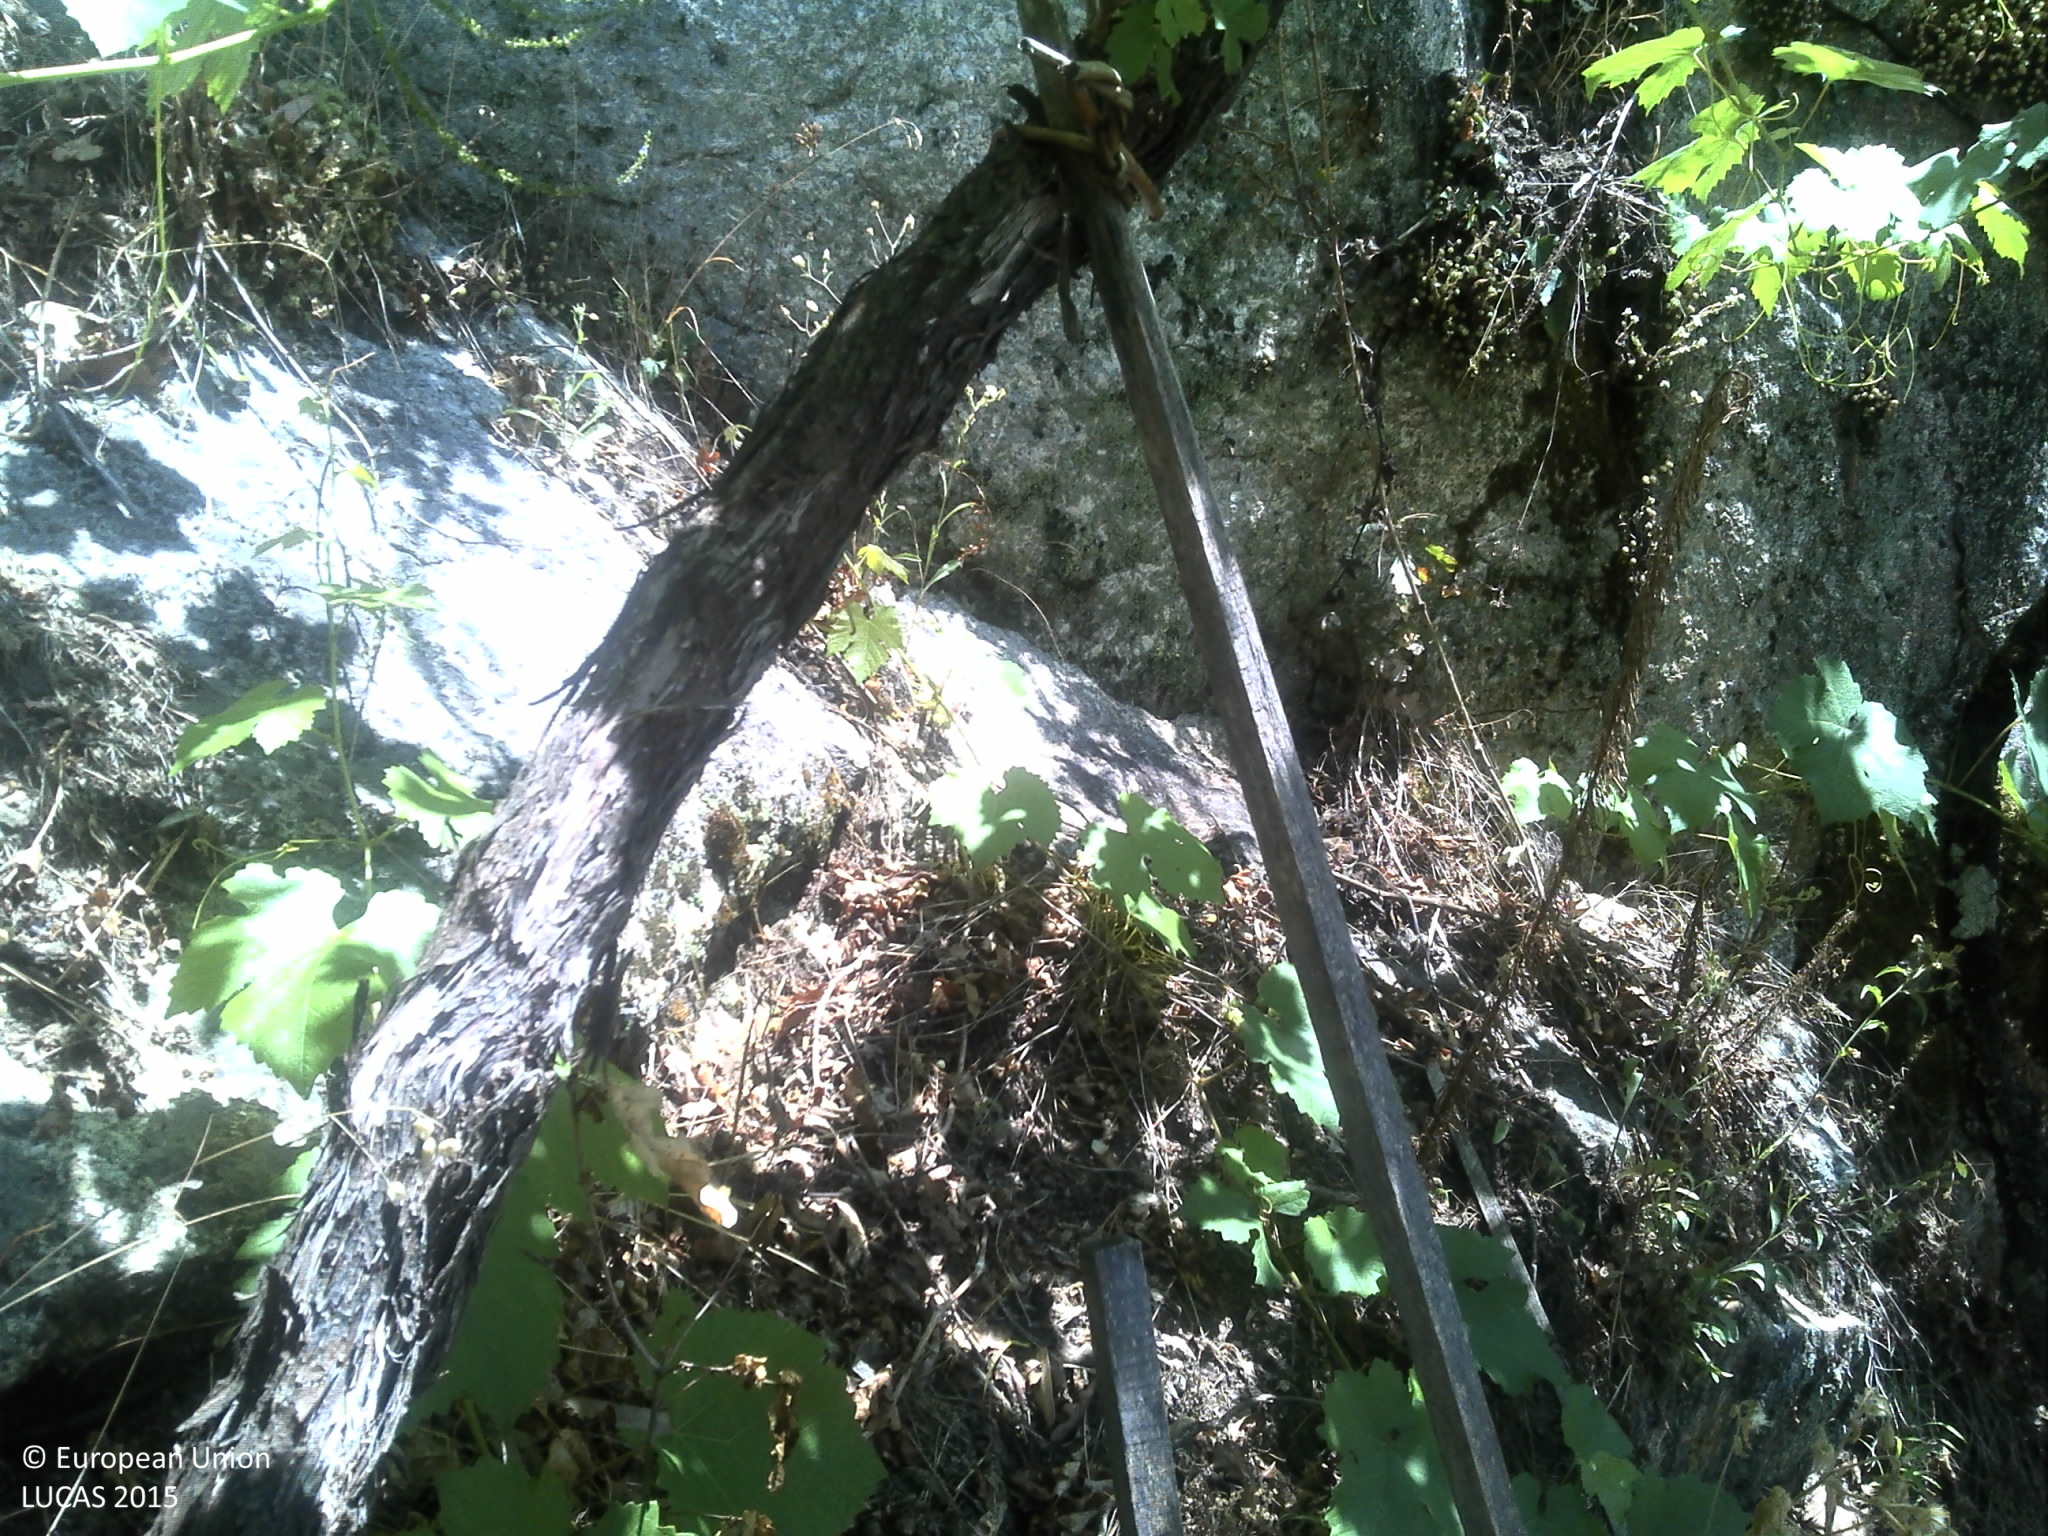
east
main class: Cropland
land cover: Vineyards
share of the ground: 50 - 75 %
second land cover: Other bare soil
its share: > 75 %
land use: Agriculture (excluding fallow land and kitchen gardens)
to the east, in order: Vineyards; Other bare soil; Grassland without tree/shrub cover; Rock outcrops; Broadleaved woodland; Pine dominated coniferous woodland; Maize; Vineyards; Pine dominated coniferous woodland; Shrubland with sparse tree cover
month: June
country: PT
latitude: 41.2295
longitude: -7.9954
